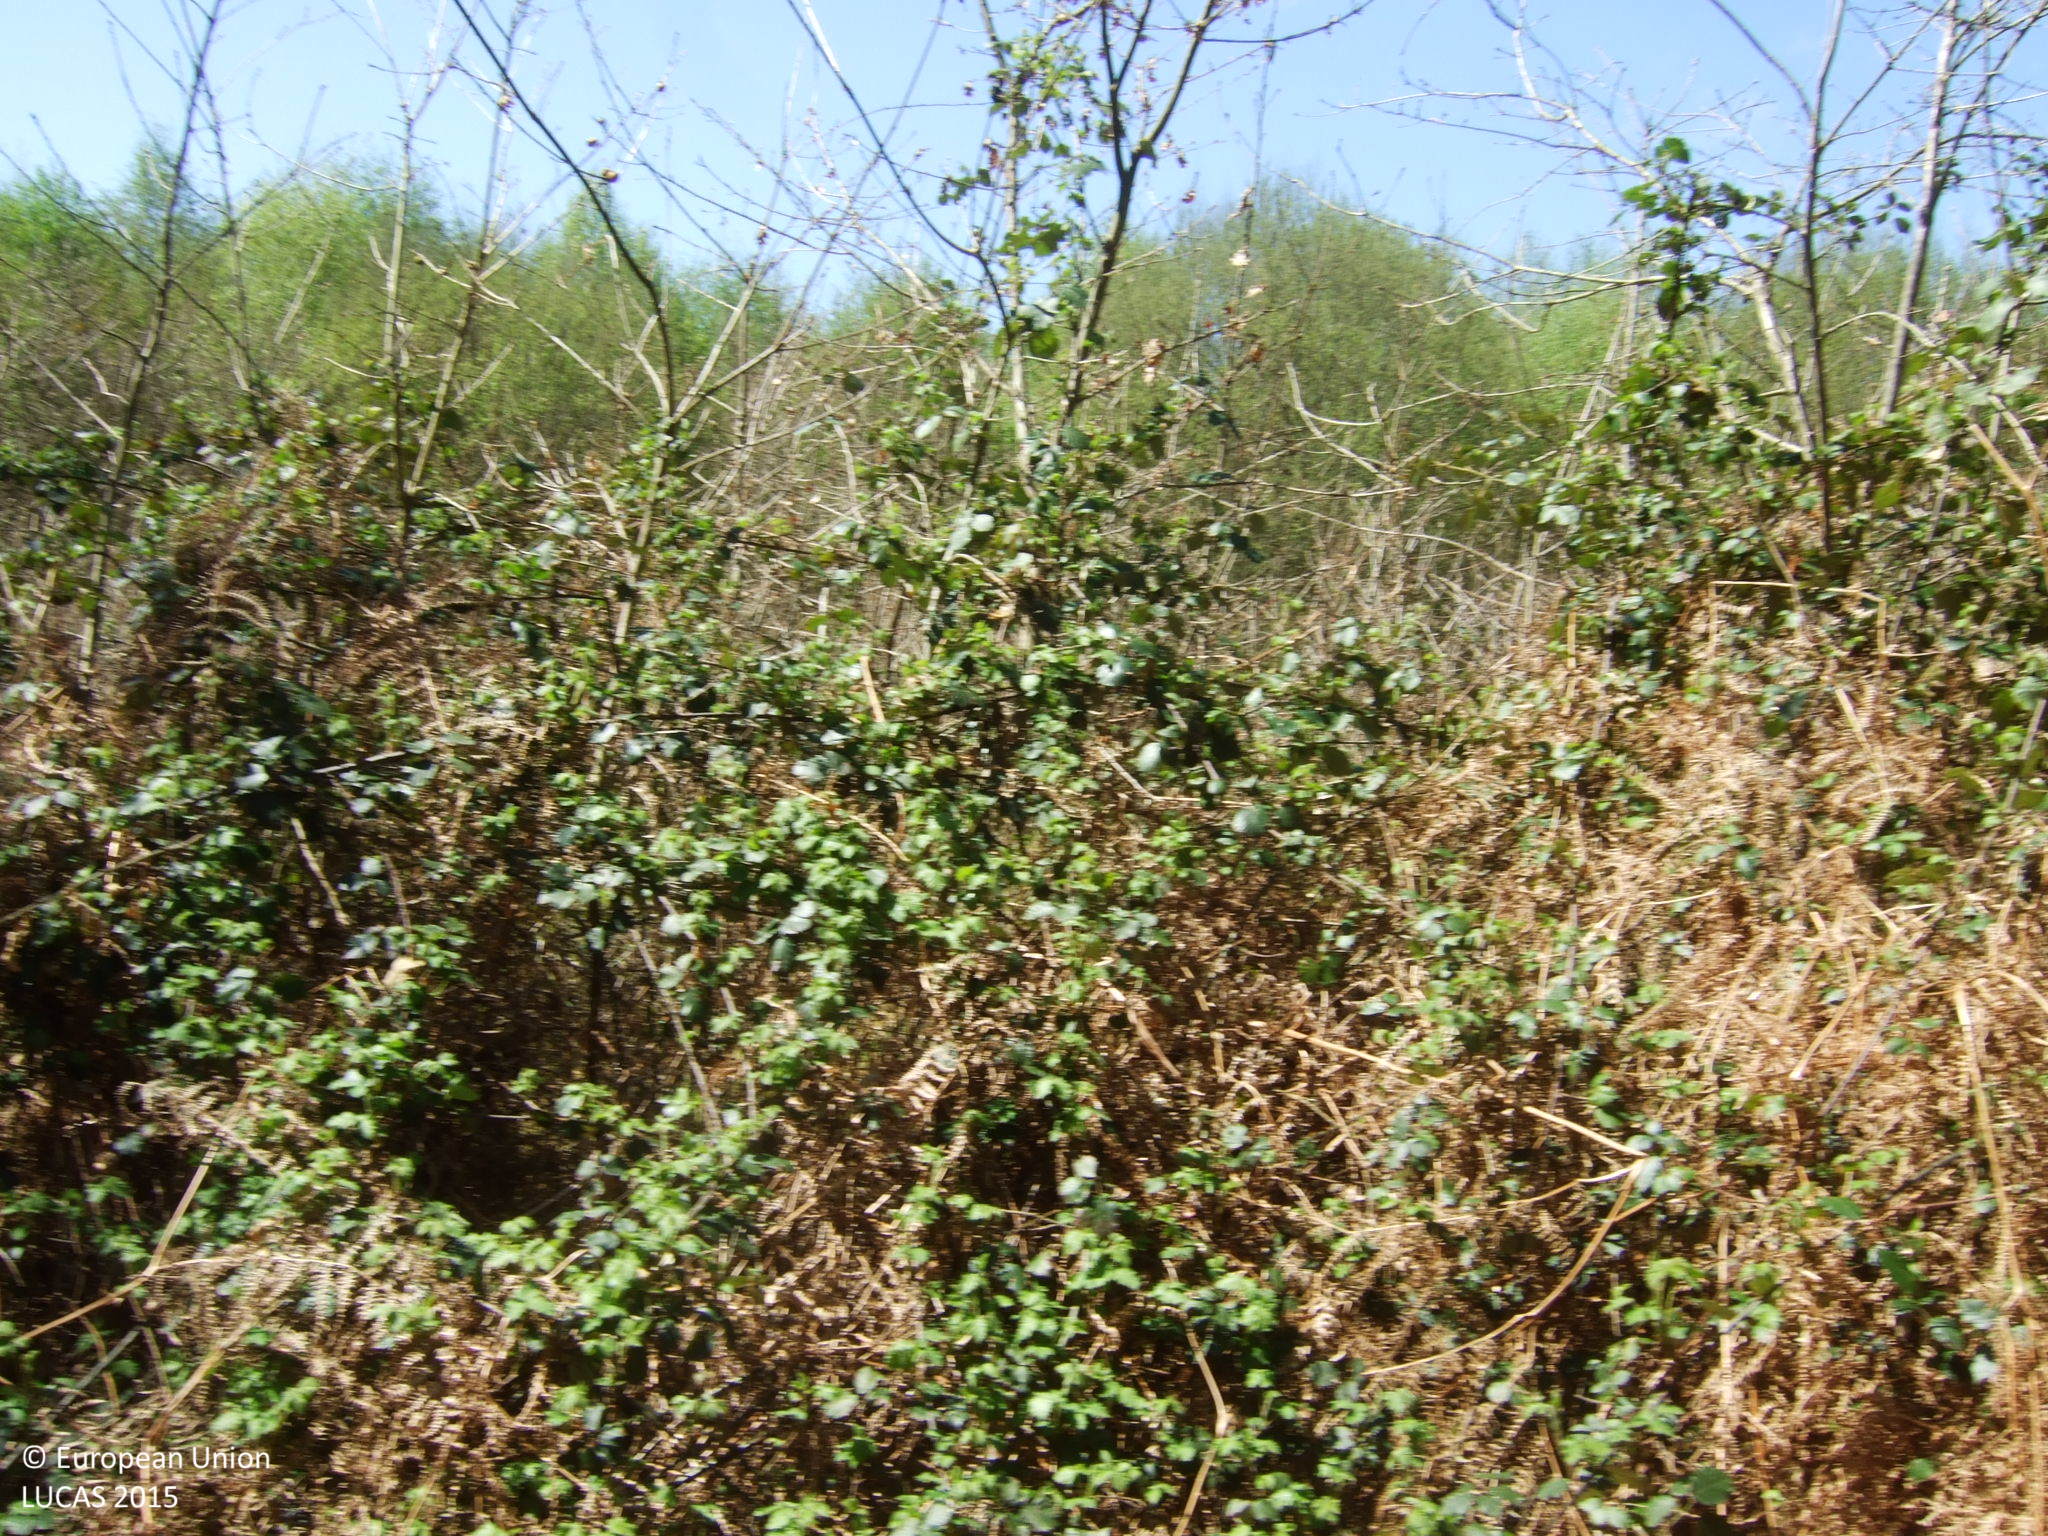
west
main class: Woodland
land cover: Broadleaved woodland
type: acidophilous oak and oak-birch forest
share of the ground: 25 - 50 %
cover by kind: broadleaved forest trees 50 %, shrubs 50 %
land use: Forestry
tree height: > 5 m
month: April
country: ES
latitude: 43.0054
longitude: -7.6598
